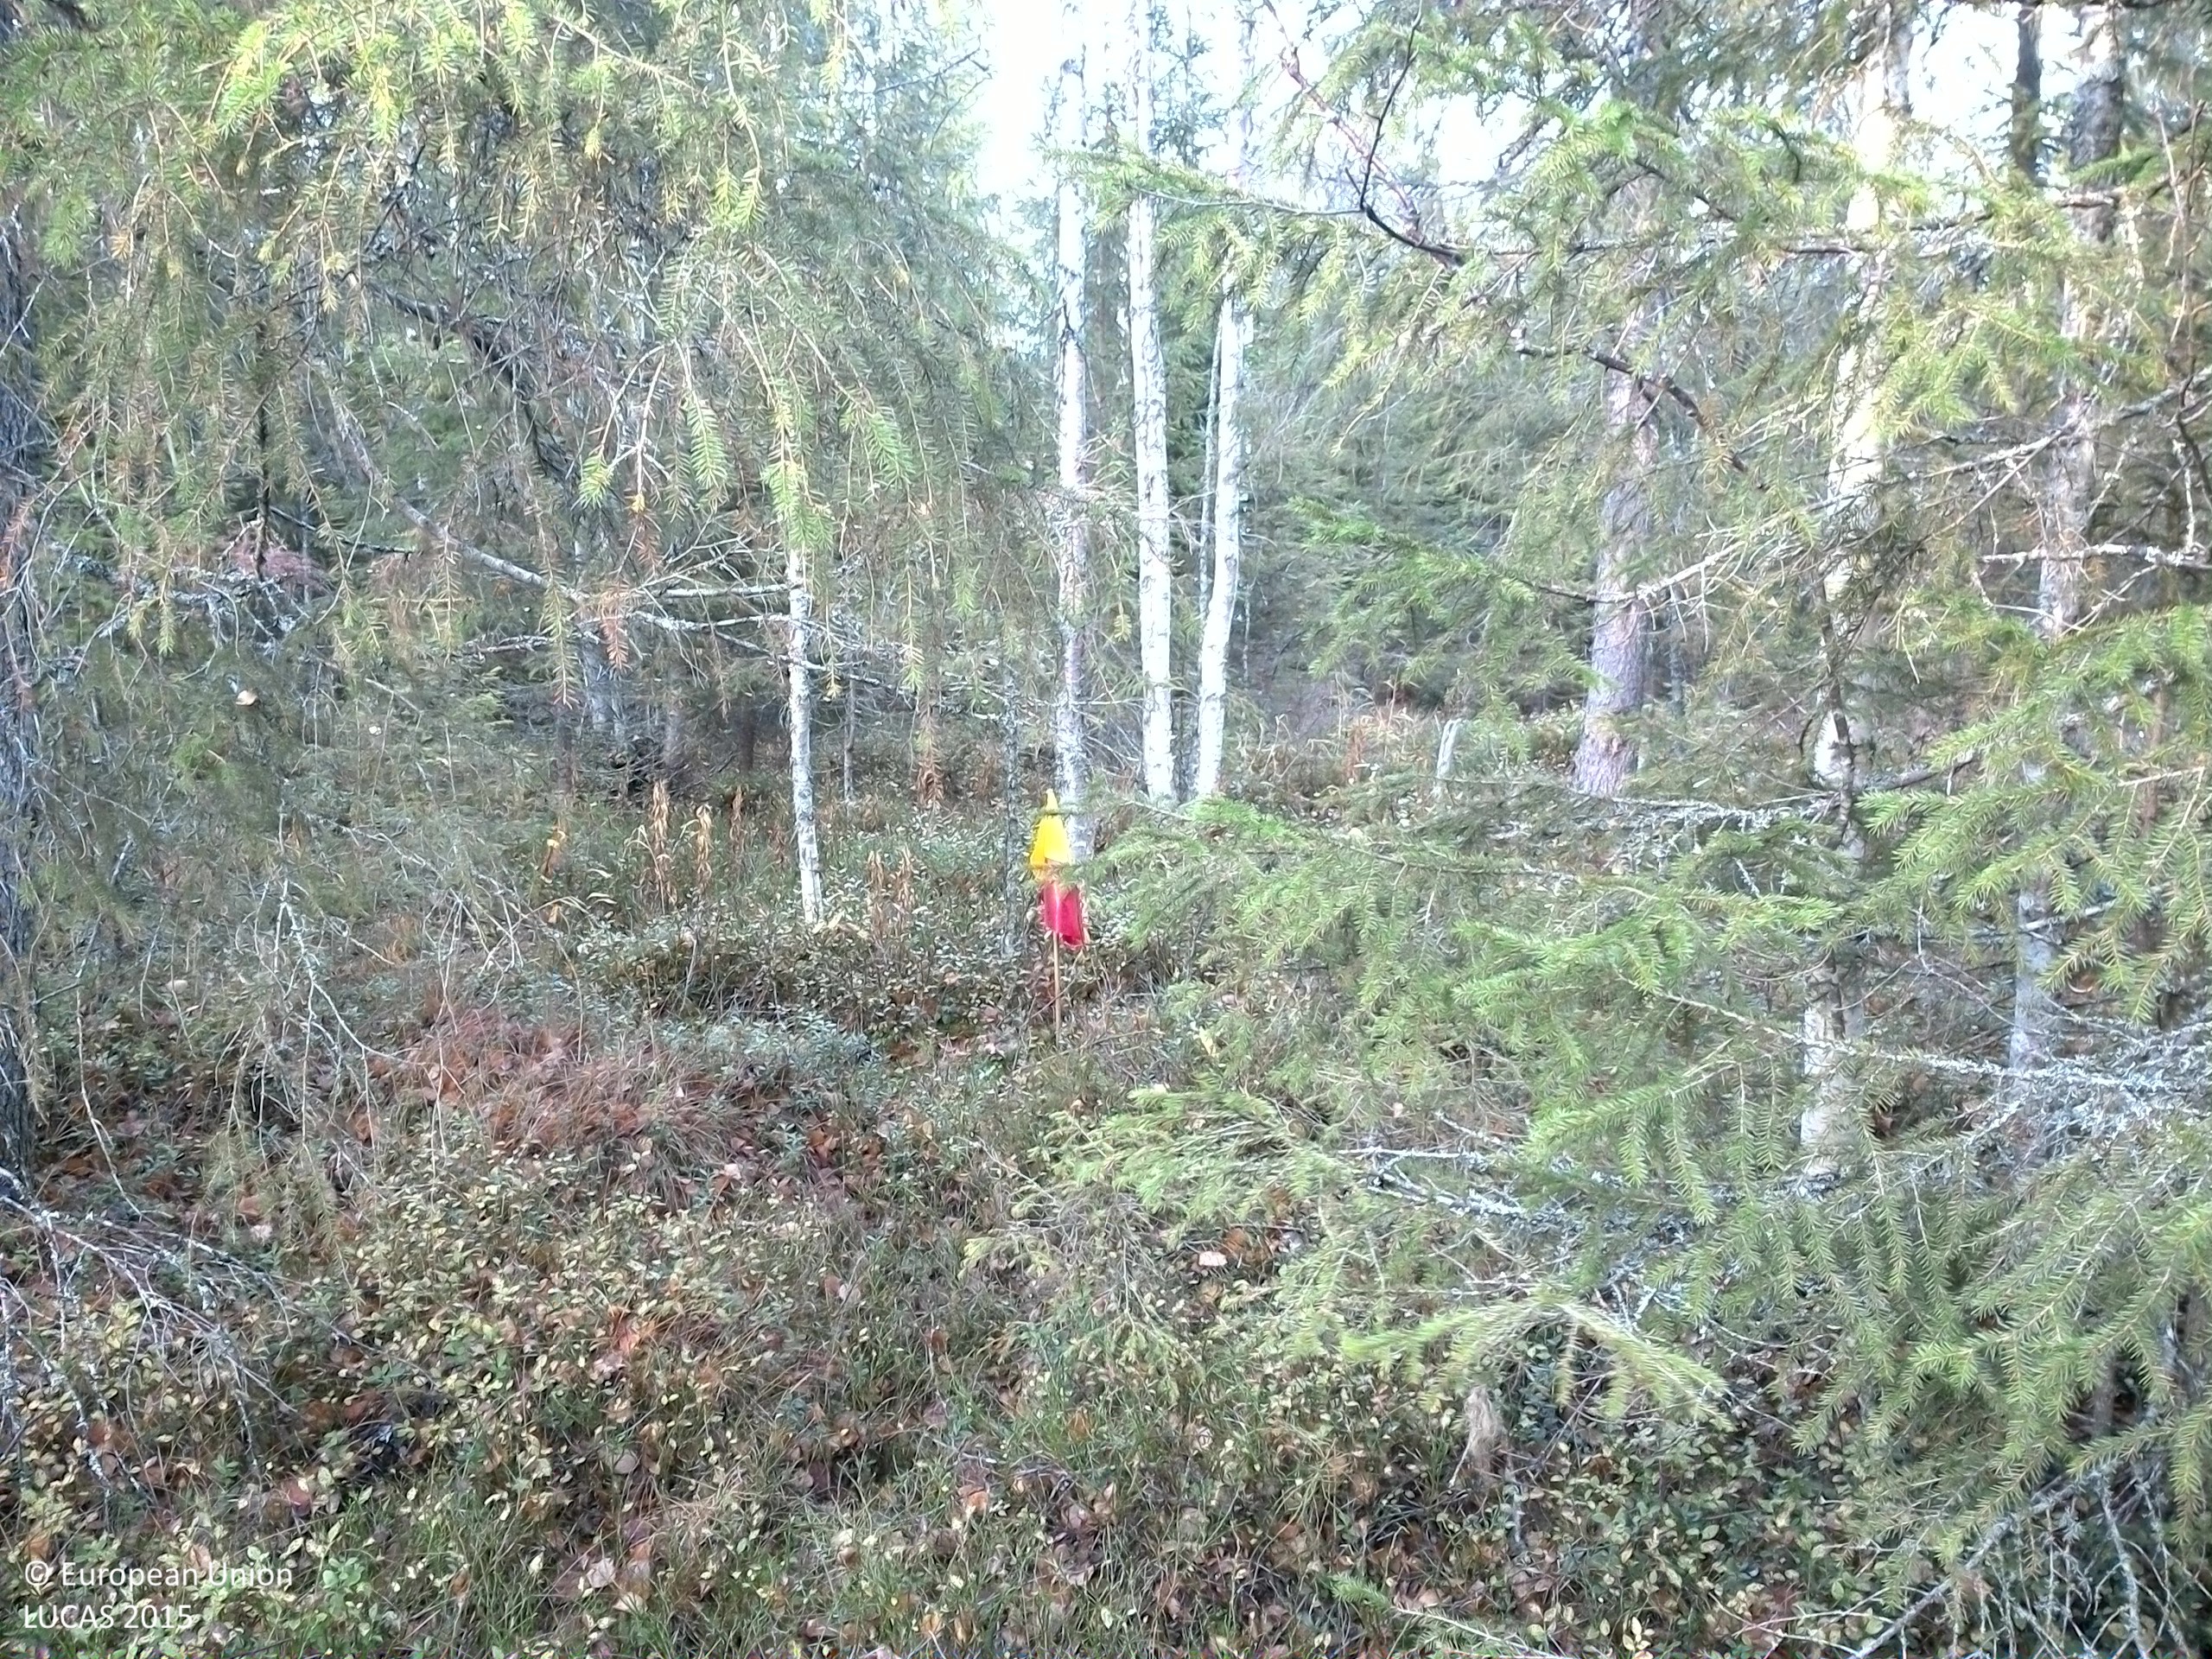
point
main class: Woodland
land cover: Spruce dominated mixed woodland
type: boreal forest
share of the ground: 50 - 75 %
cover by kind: coniferous forest trees 50 %, broadleaved forest trees 20 %, shrubs 20 %, lichens and mosses 10 %
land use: Forestry
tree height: > 5 m
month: October
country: SE
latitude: 64.1432
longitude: 15.9102
